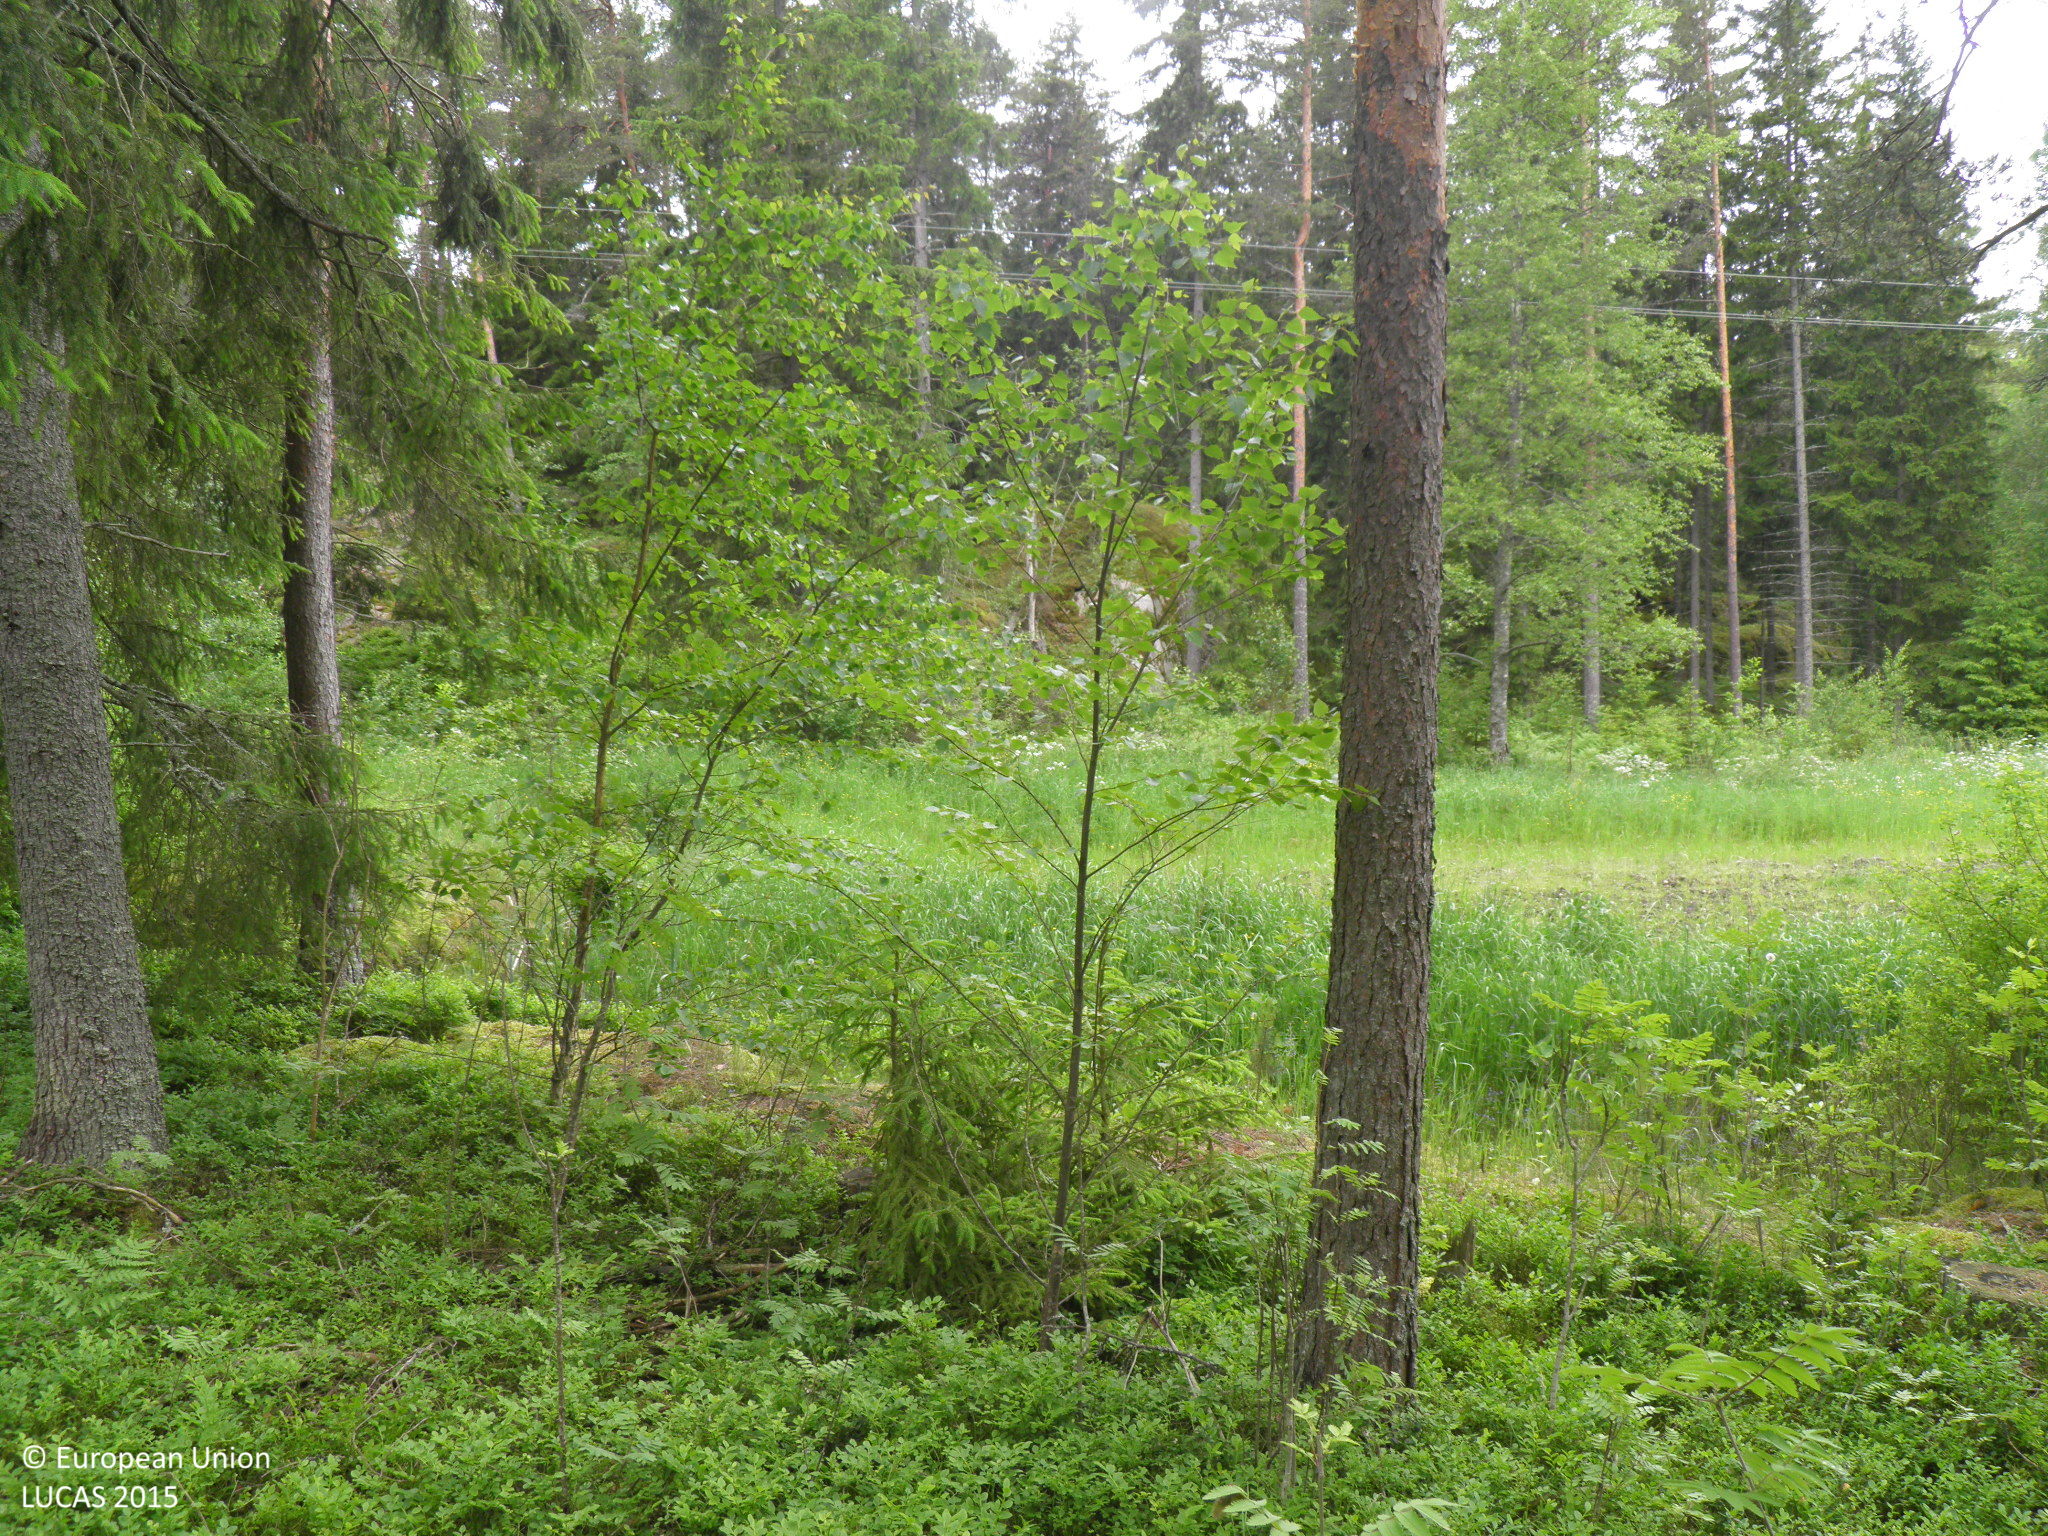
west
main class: Woodland
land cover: Other coniferous woodland
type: hemiboreal forest and nemoral coniferous forest and mixed broadleaved-coniferous forest
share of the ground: > 75 %
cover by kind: coniferous forest trees 70 %, broadleaved forest trees 10 %, shrubs 10 %, herbaceous plants 10 %
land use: Forestry
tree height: > 5 m
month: June
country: FI
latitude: 60.3079
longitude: 22.1746
